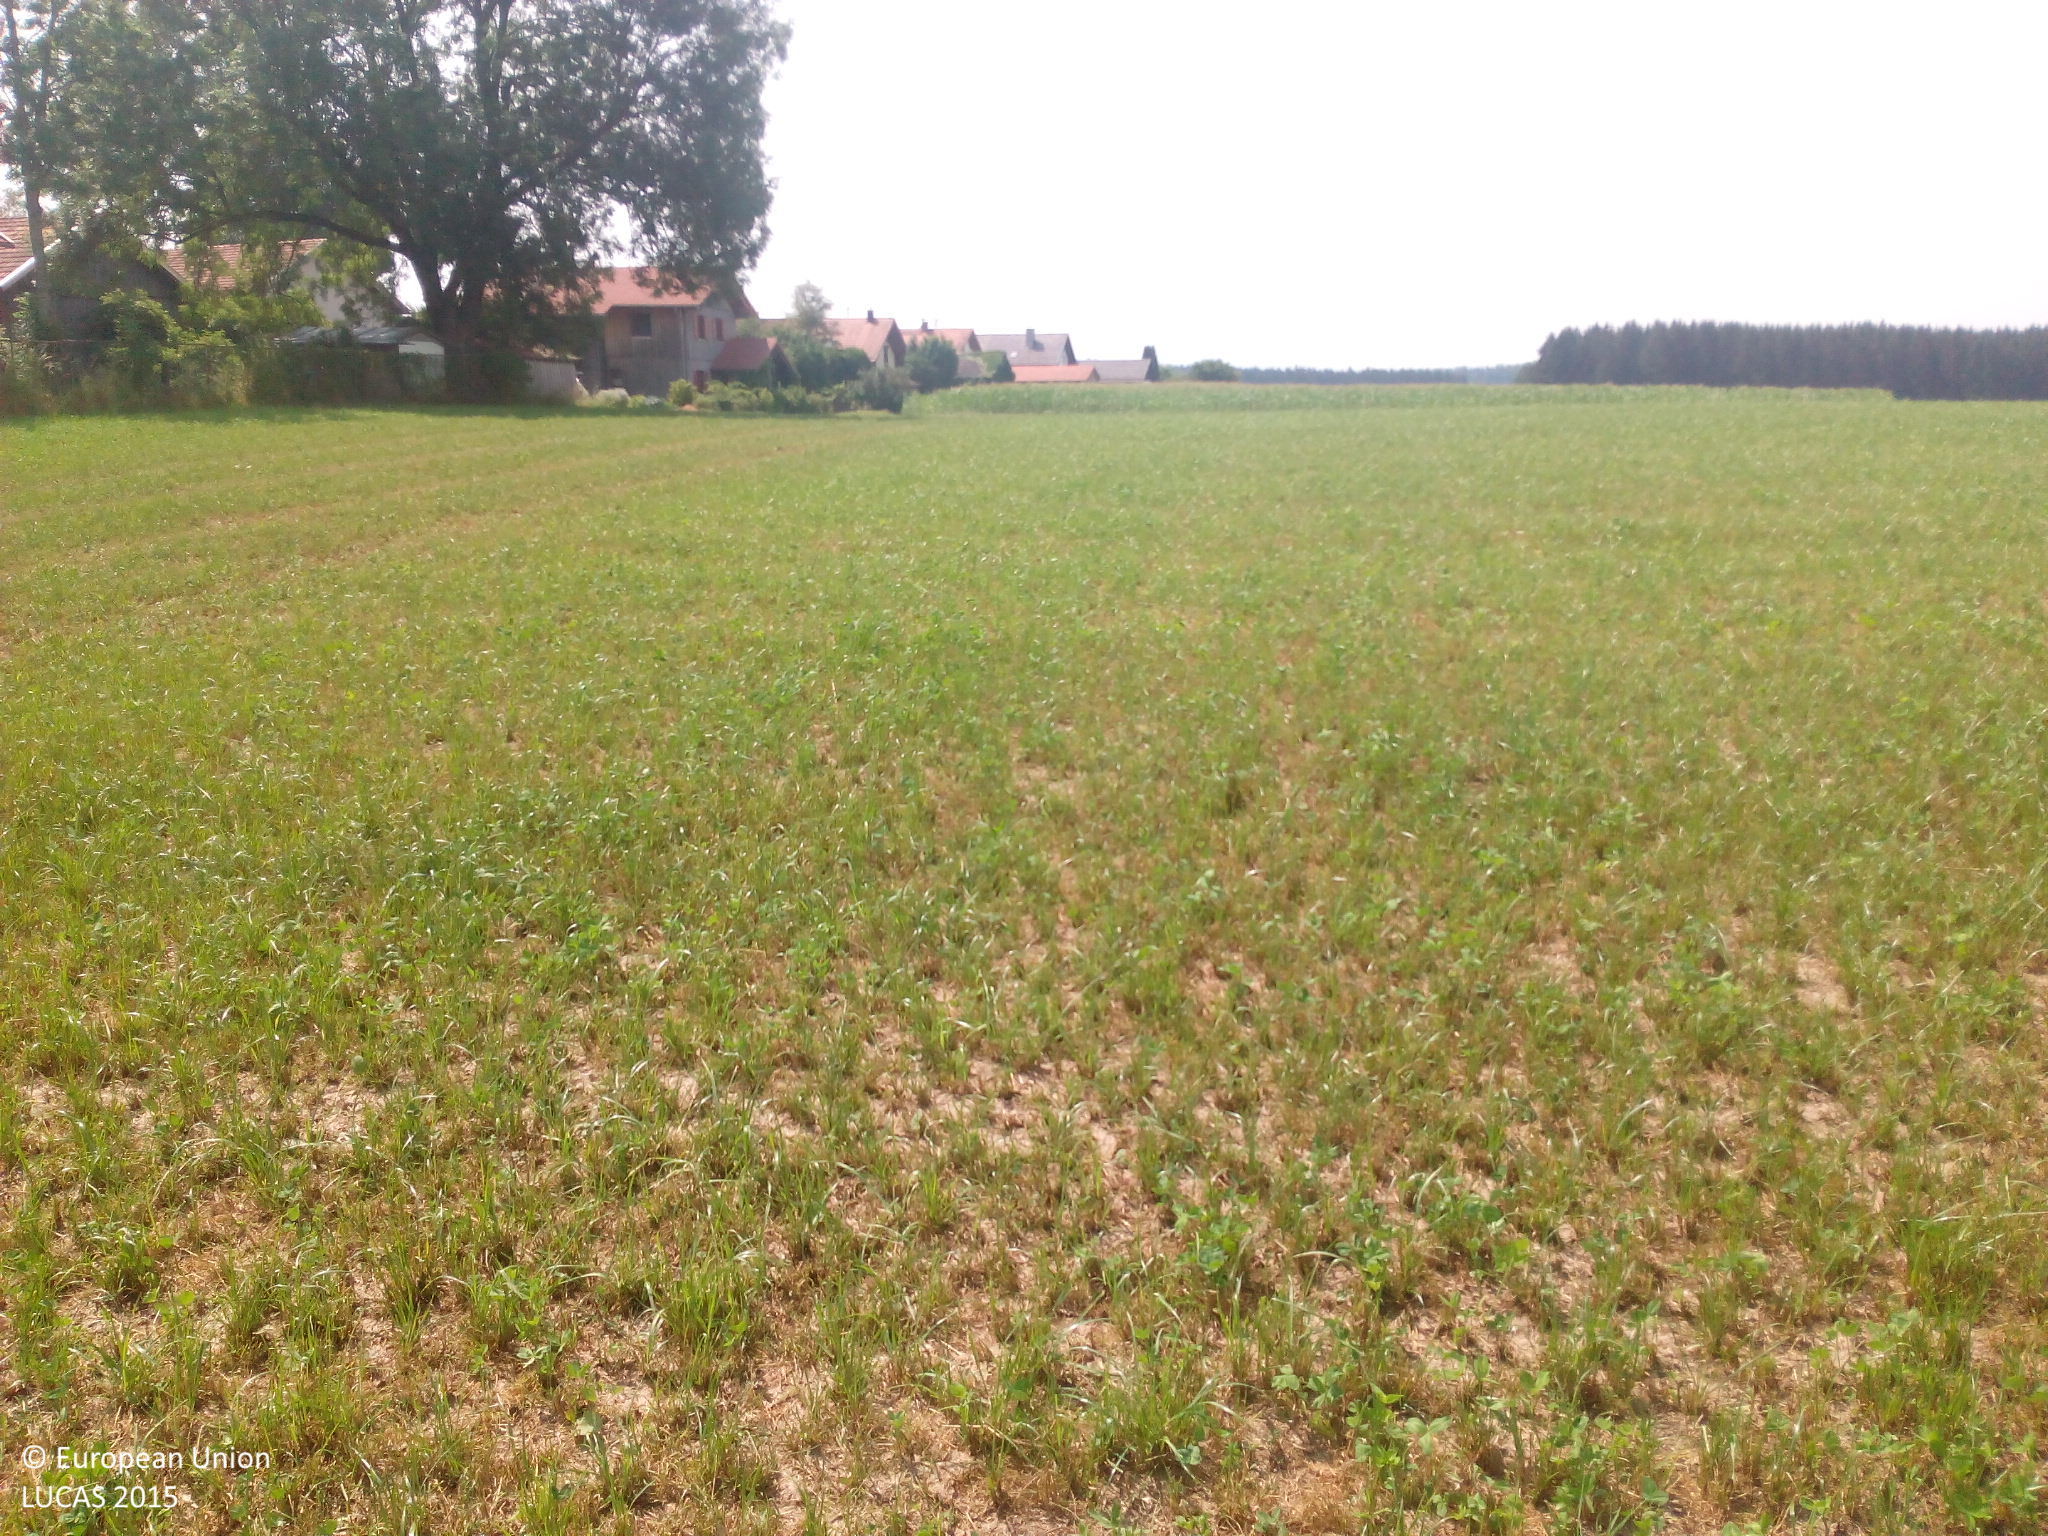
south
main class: Cropland
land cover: Temporary grasslands
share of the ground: 50 - 75 %
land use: Agriculture (excluding fallow land and kitchen gardens)
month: July
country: DE
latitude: 47.8595
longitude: 10.9483
